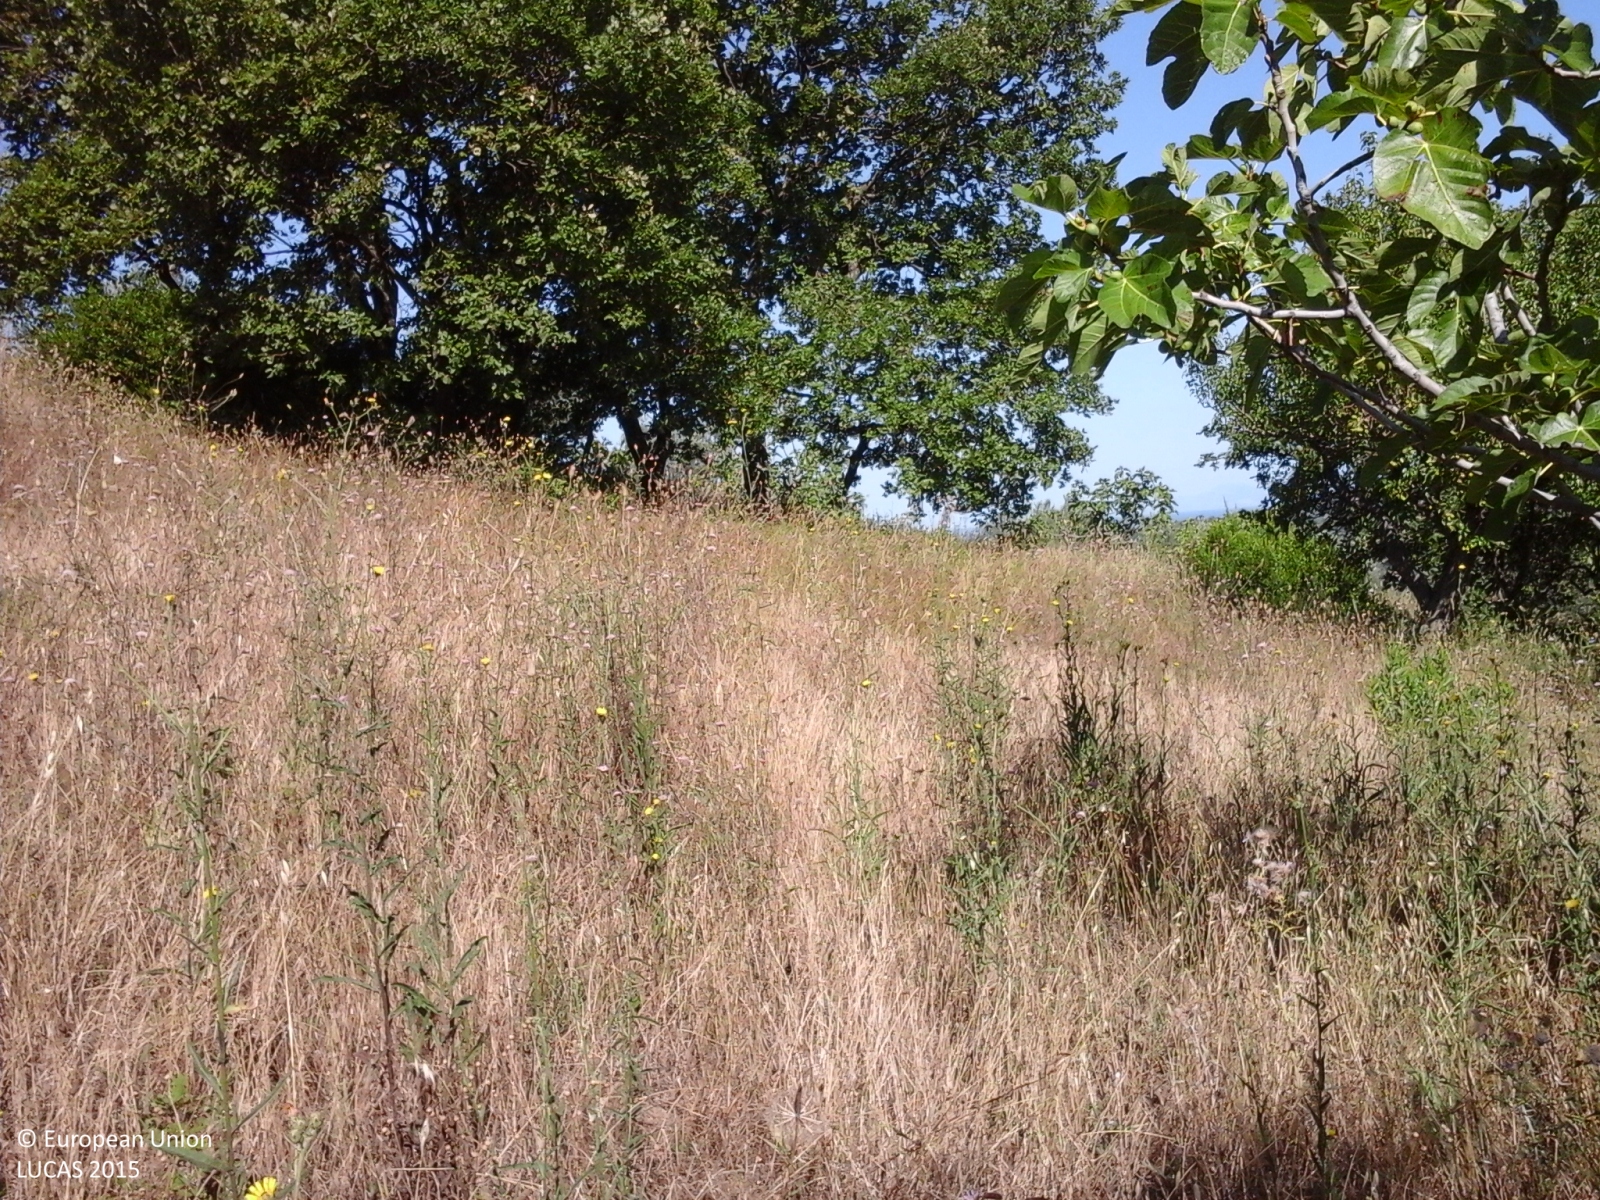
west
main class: Cropland
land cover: Olive groves
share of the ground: 25 - 50 %
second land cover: Other fruit trees and berries
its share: 25 - 50 %
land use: Agriculture (excluding fallow land and kitchen gardens)
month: June
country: IT
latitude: 40.3884
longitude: 15.1024
